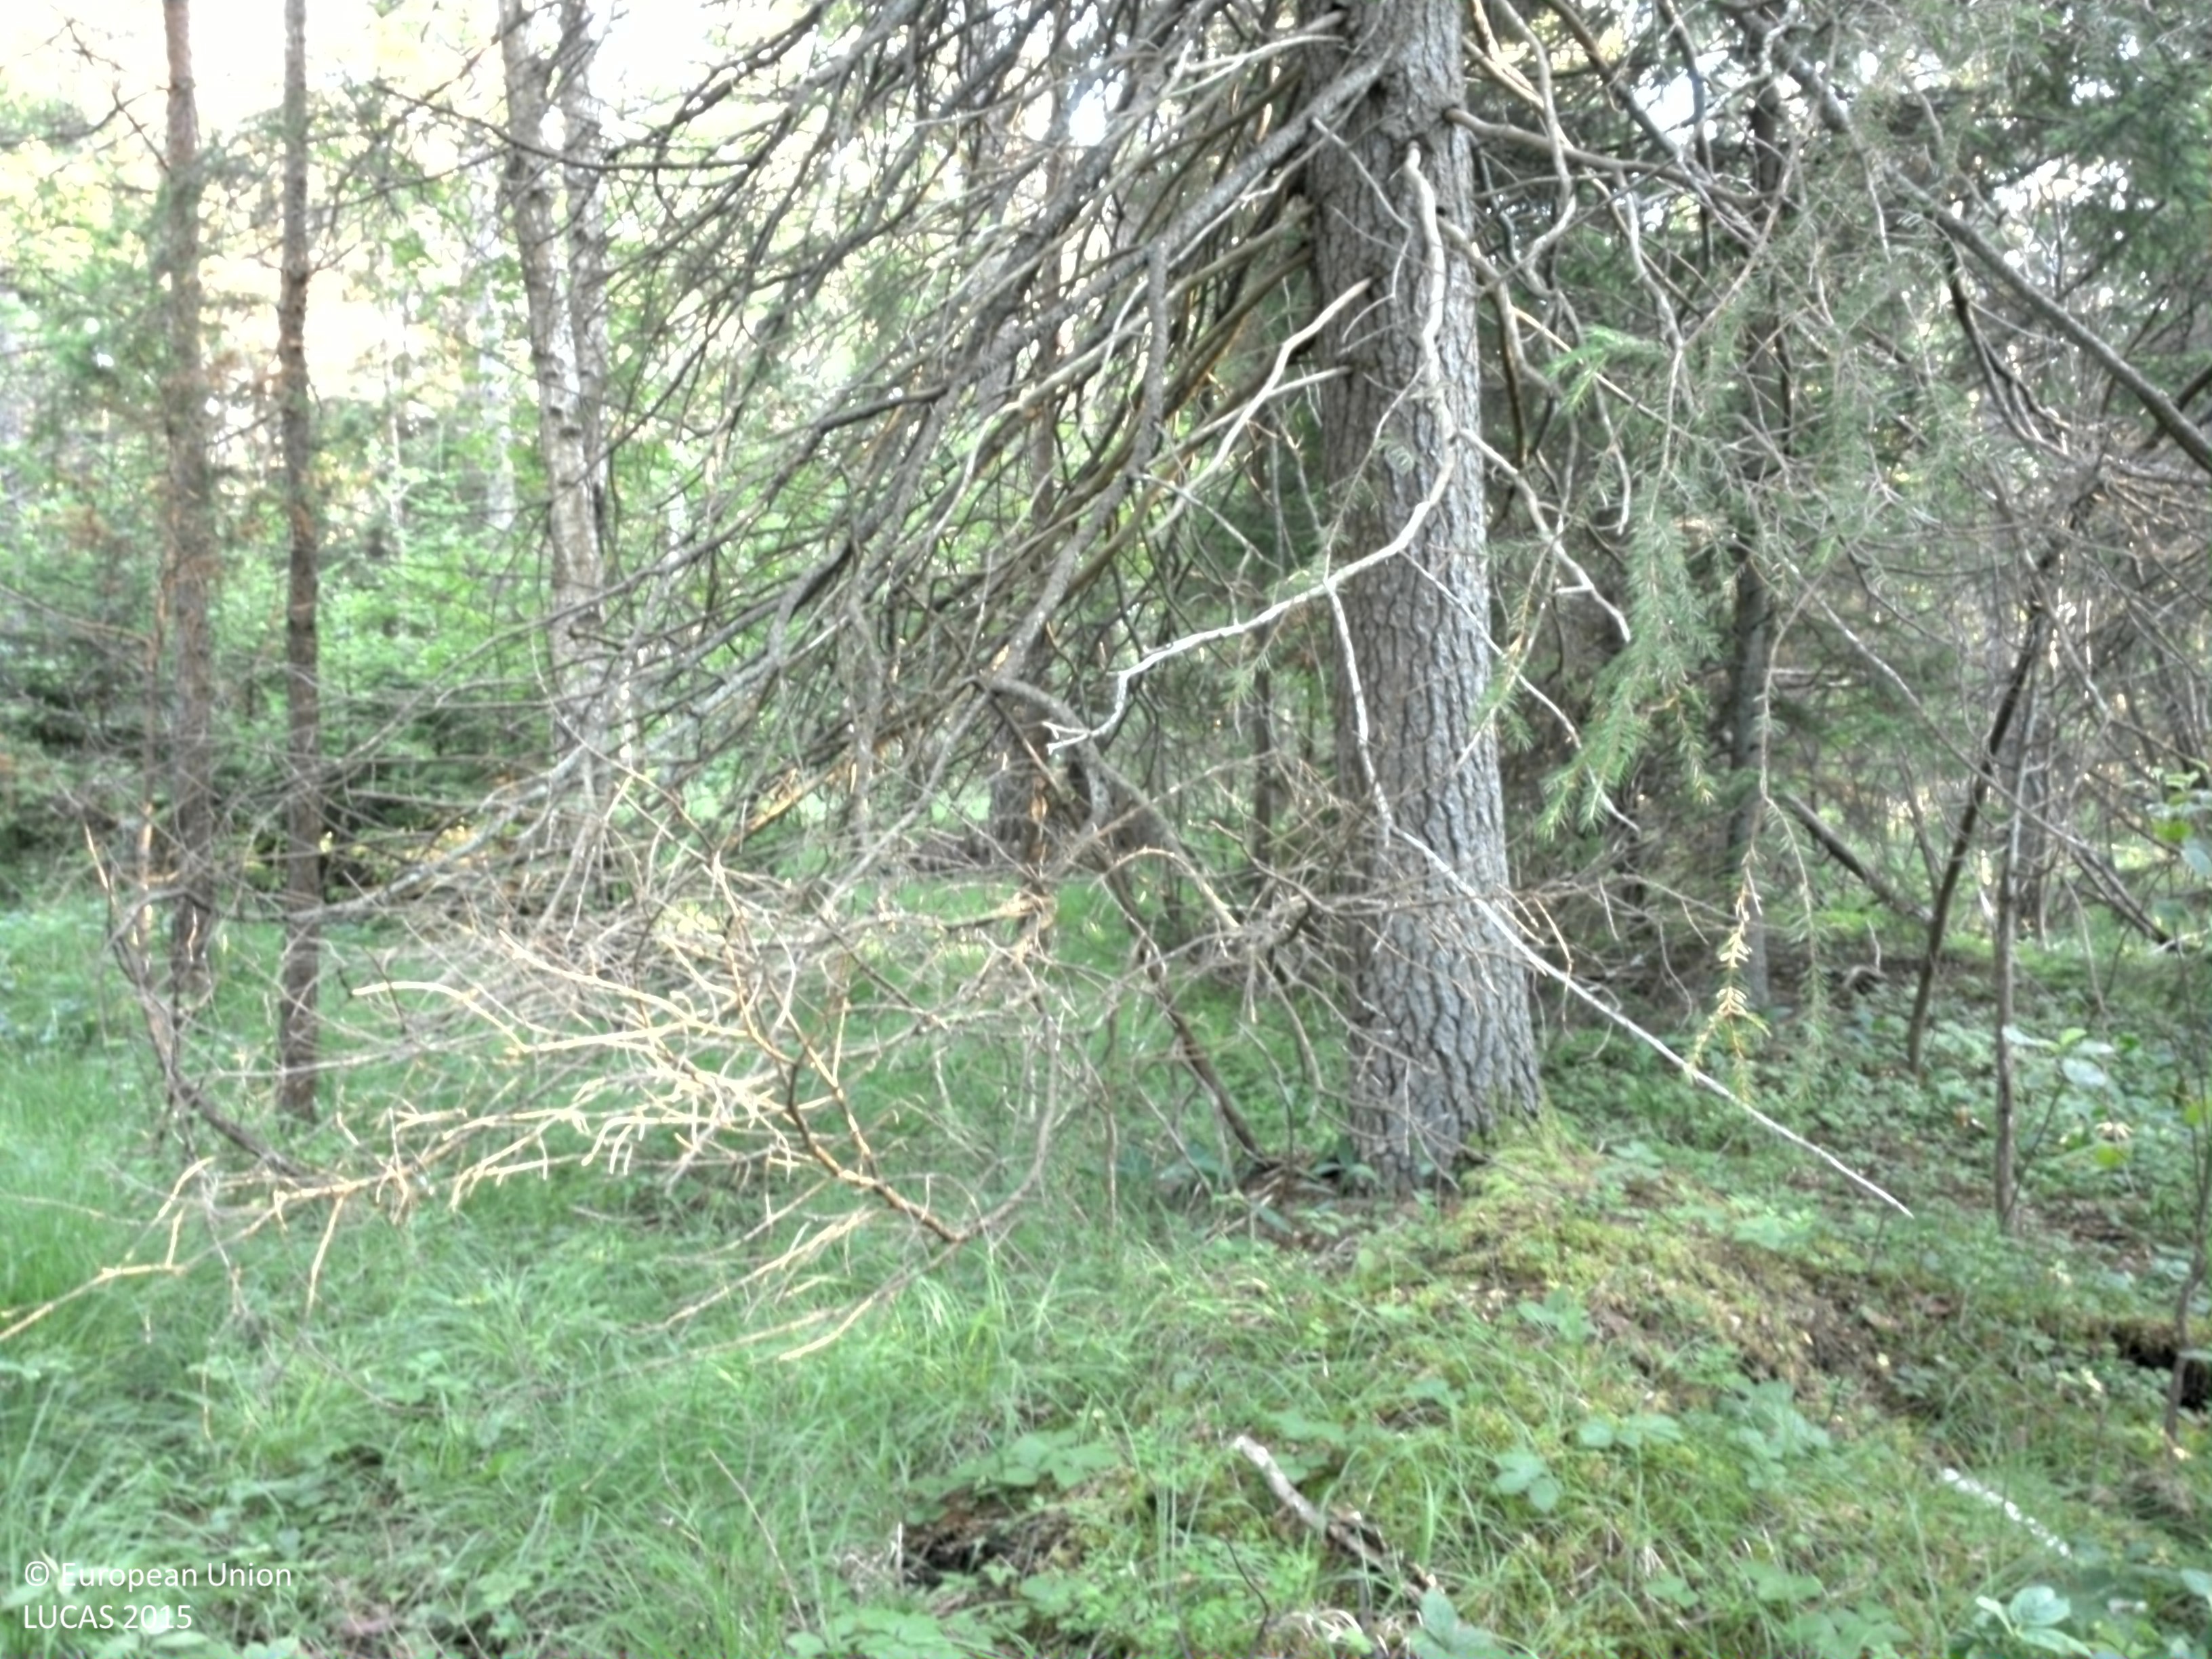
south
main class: Woodland
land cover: Pine dominated mixed woodland
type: hemiboreal forest and nemoral coniferous forest and mixed broadleaved-coniferous forest
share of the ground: > 75 %
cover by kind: coniferous forest trees 55 %, broadleaved forest trees 20 %, herbaceous plants 20 %, shrubs 5 %
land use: Forestry
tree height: > 5 m
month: July
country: SE
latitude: 57.4332
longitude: 18.6548
